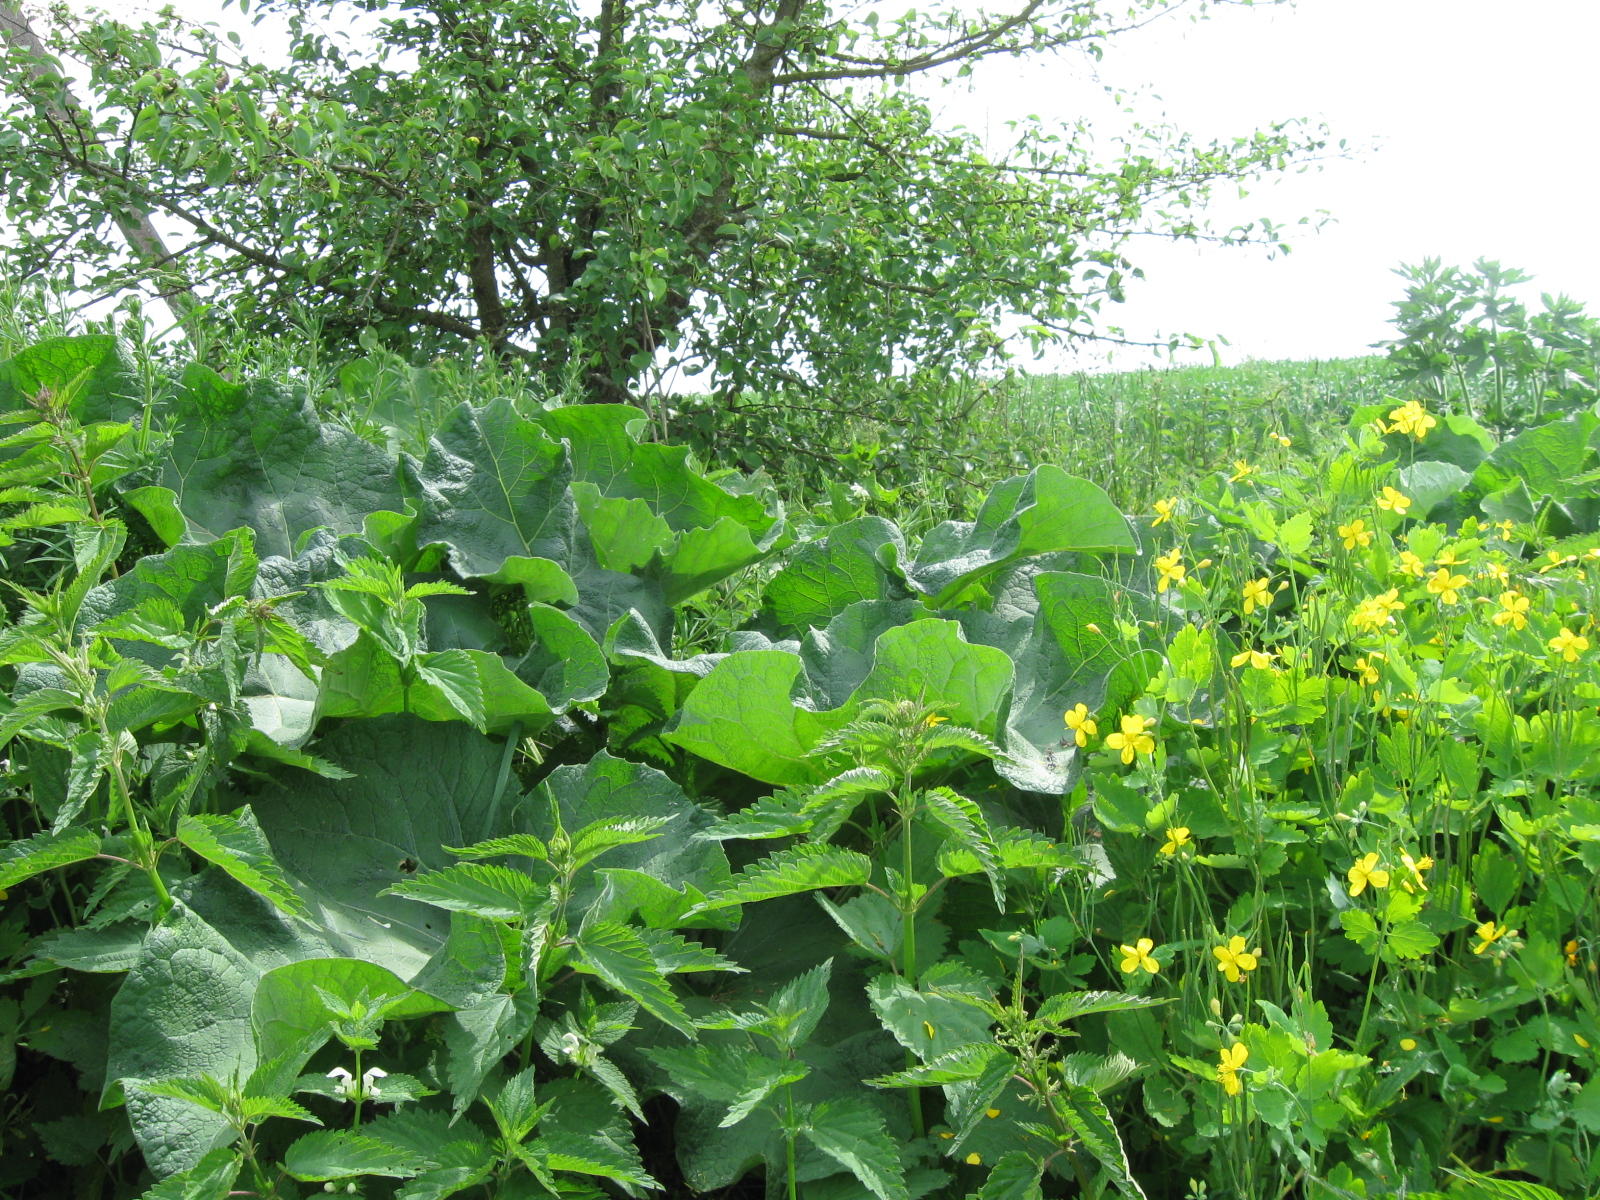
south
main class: Woodland
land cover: Broadleaved woodland
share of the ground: > 75 %
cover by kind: broadleaved forest trees 75 %, herbaceous plants 25 %
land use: Semi-natural and natural areas not in use
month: June
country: LT
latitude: 54.3244
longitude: 23.7876
